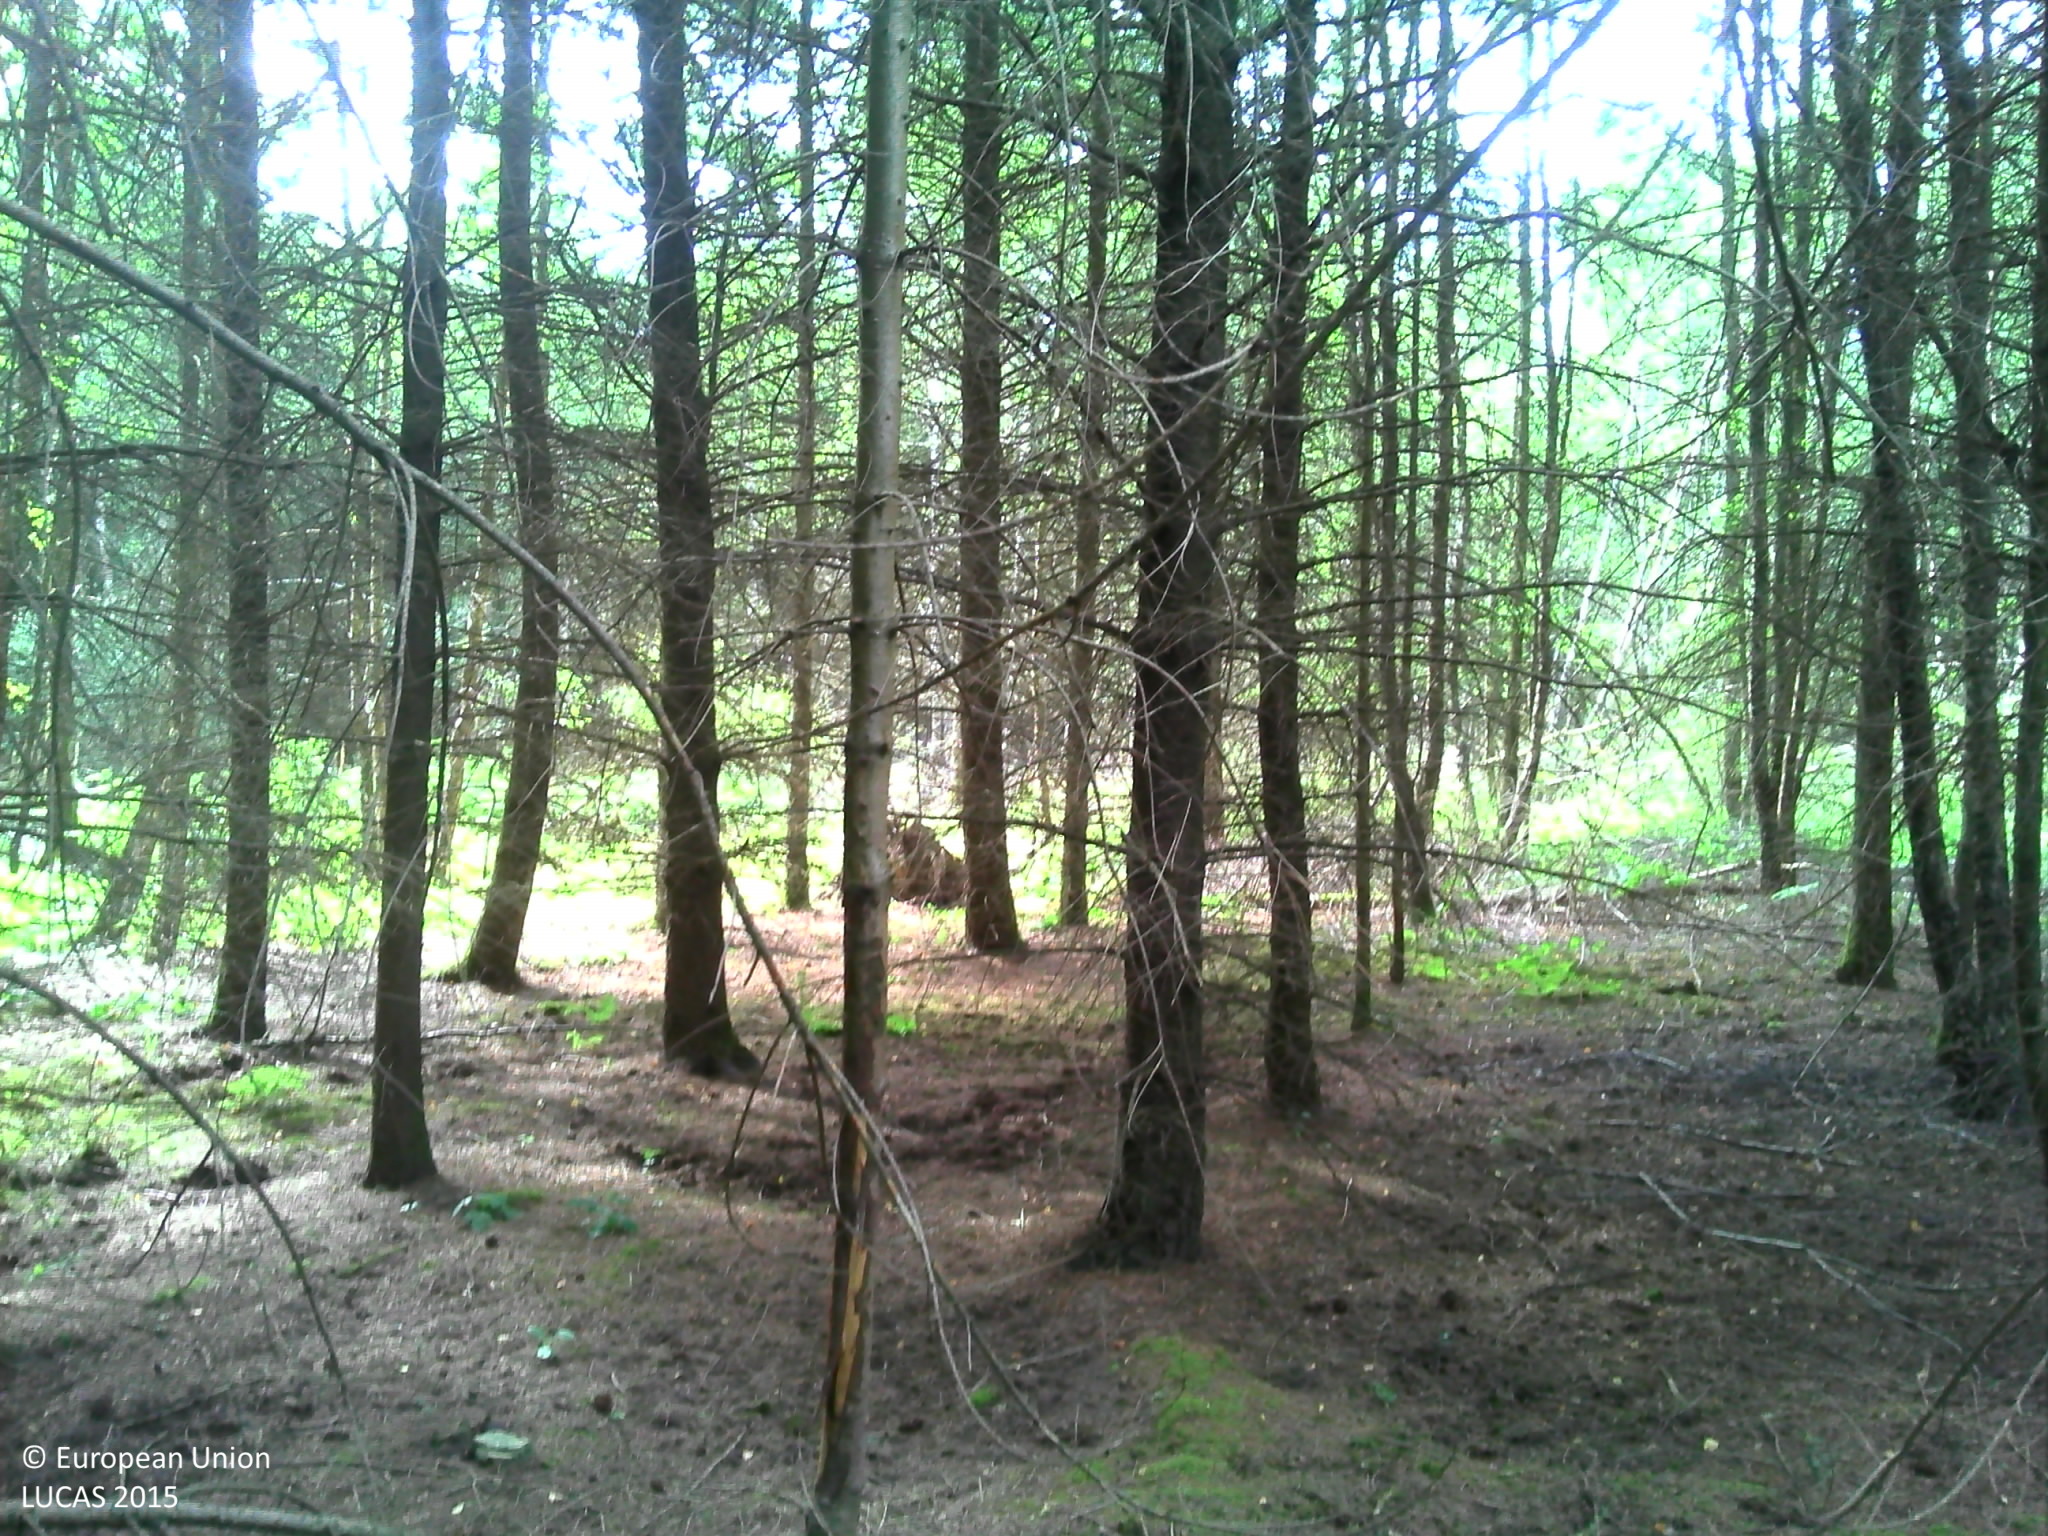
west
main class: Woodland
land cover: Spruce dominated coniferous woodland
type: mesophytic deciduous forest
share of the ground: > 75 %
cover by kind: coniferous forest trees 95 %, herbaceous plants 5 %
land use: Forestry
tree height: > 5 m
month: August
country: FR
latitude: 48.5111
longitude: -0.1976
